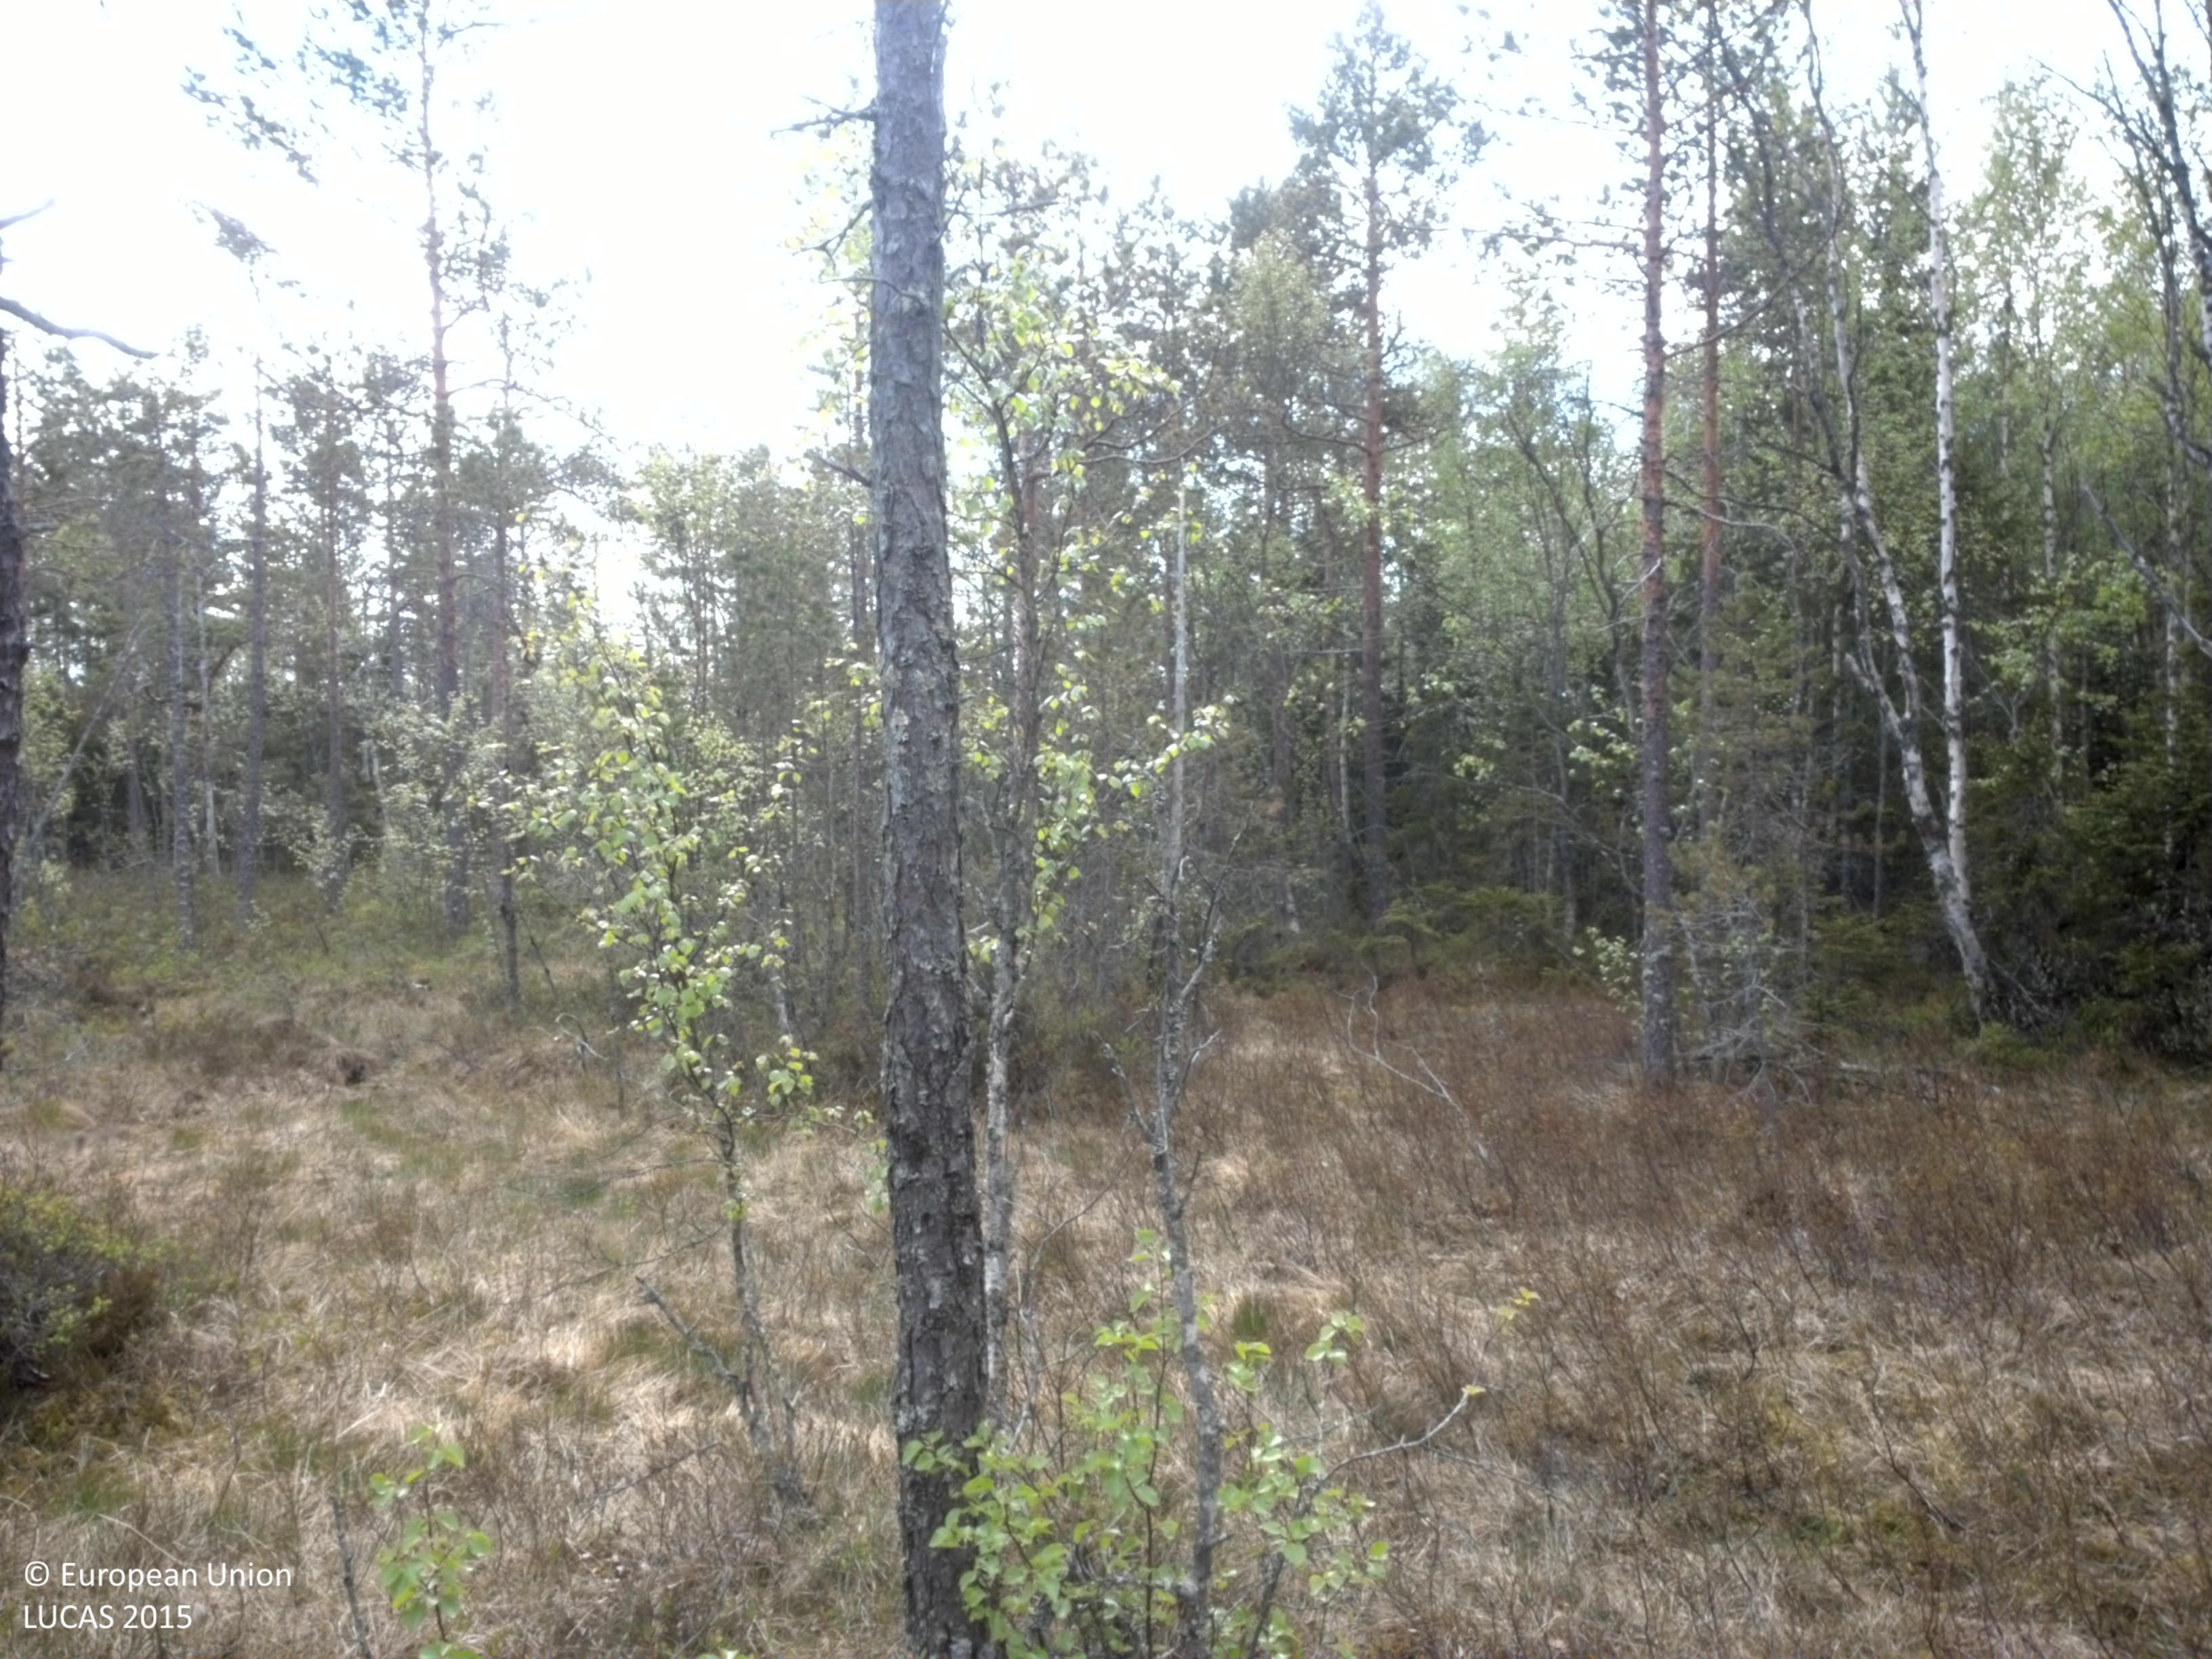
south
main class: Woodland
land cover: Pine dominated coniferous woodland
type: mire and swamp forests
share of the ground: 50 - 75 %
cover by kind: coniferous forest trees 60 %, broadleaved forest trees 15 %, shrubs 15 %, herbaceous plants 10 %
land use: Semi-natural and natural areas not in use
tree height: > 5 m
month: June
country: SE
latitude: 63.8460
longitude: 20.5370
